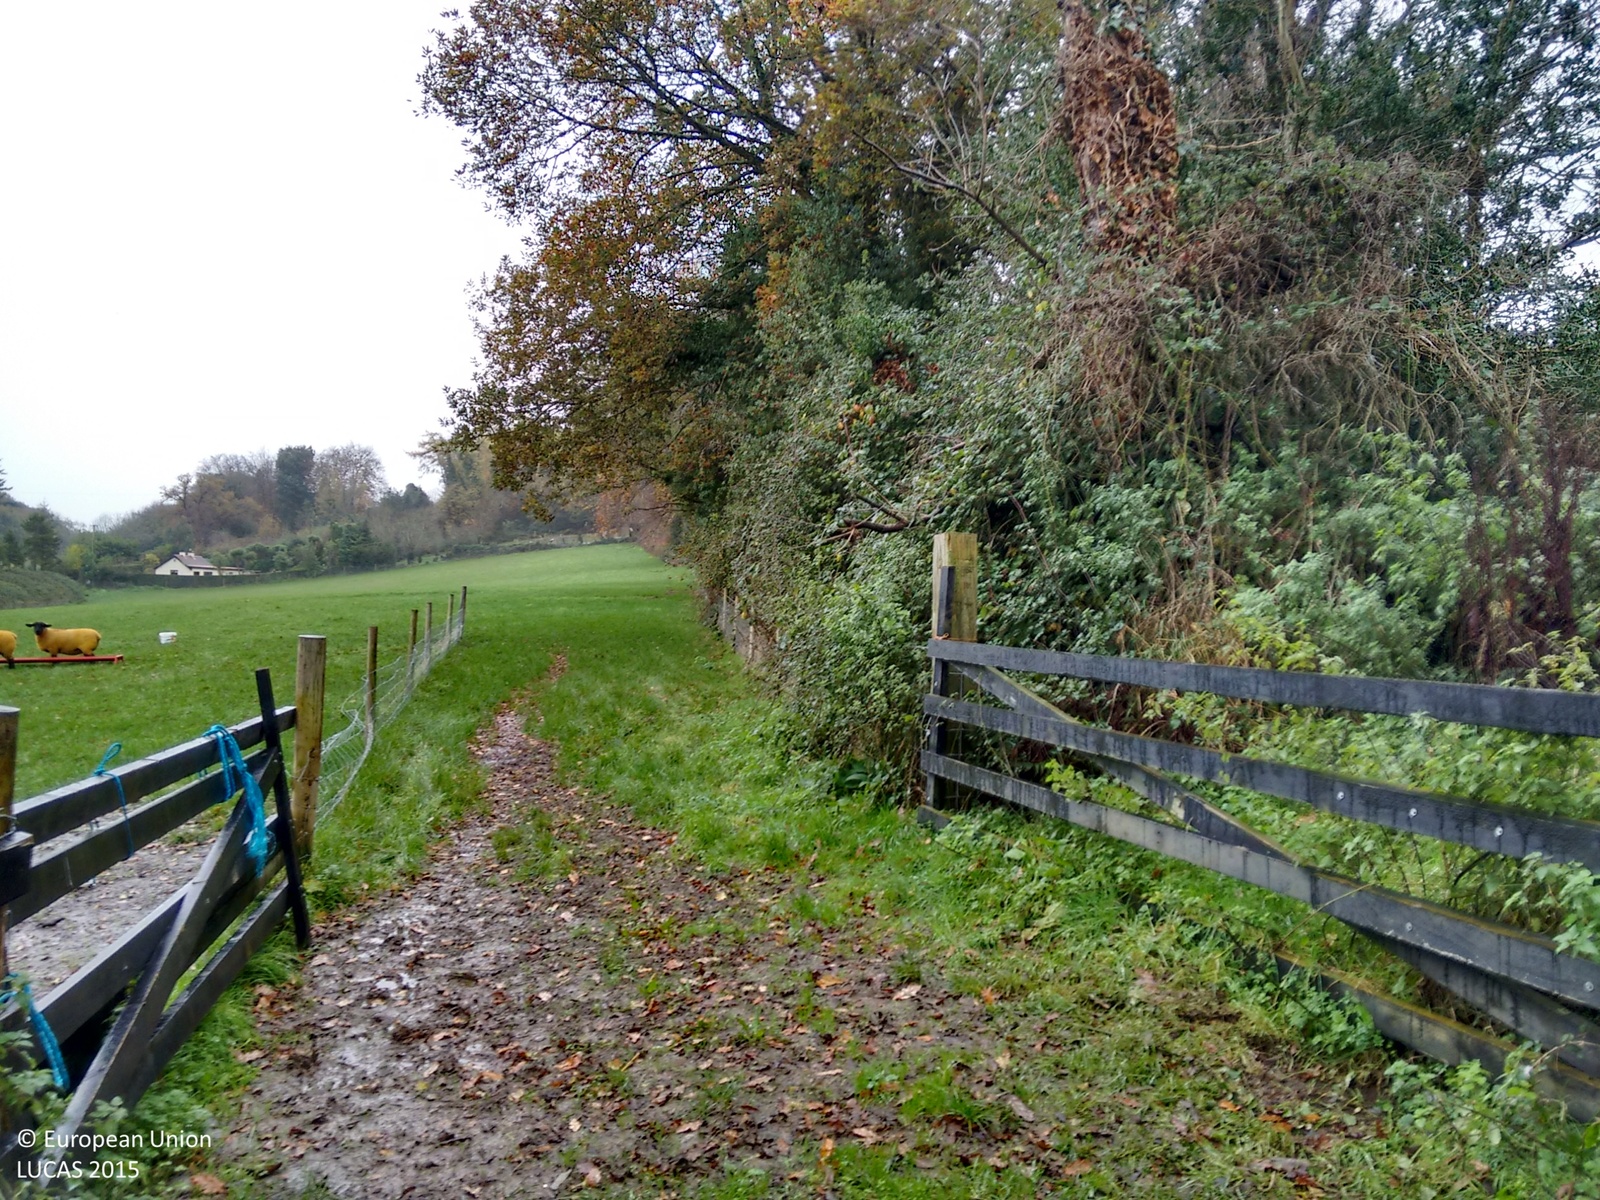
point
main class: Grassland
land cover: Grassland without tree/shrub cover
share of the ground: > 75 %
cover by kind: herbaceous plants 60 %
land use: Agriculture (excluding fallow land and kitchen gardens)
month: November
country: IE
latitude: 53.0671
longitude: -6.0990
